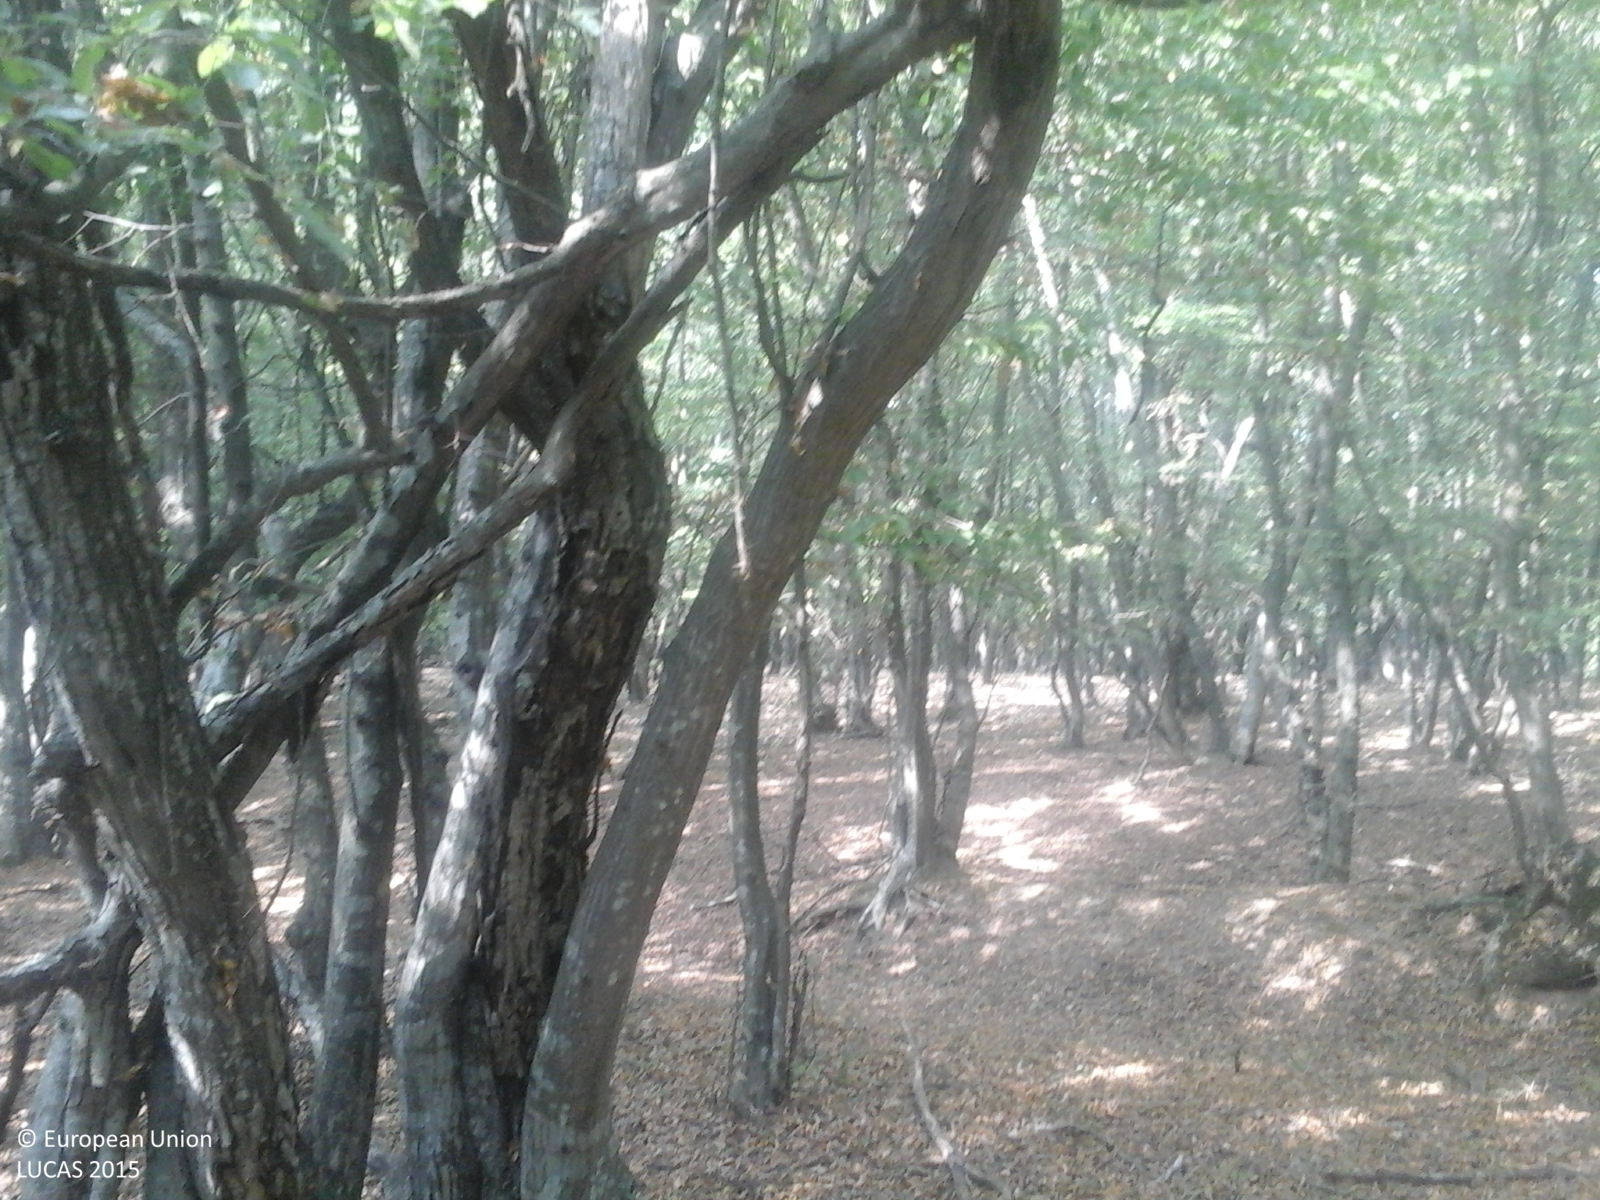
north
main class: Woodland
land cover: Broadleaved woodland
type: mesophytic deciduous forest
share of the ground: > 75 %
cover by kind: broadleaved forest trees 100 %
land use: Forestry
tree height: > 5 m
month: July
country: RO
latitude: 45.2517
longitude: 28.3076
